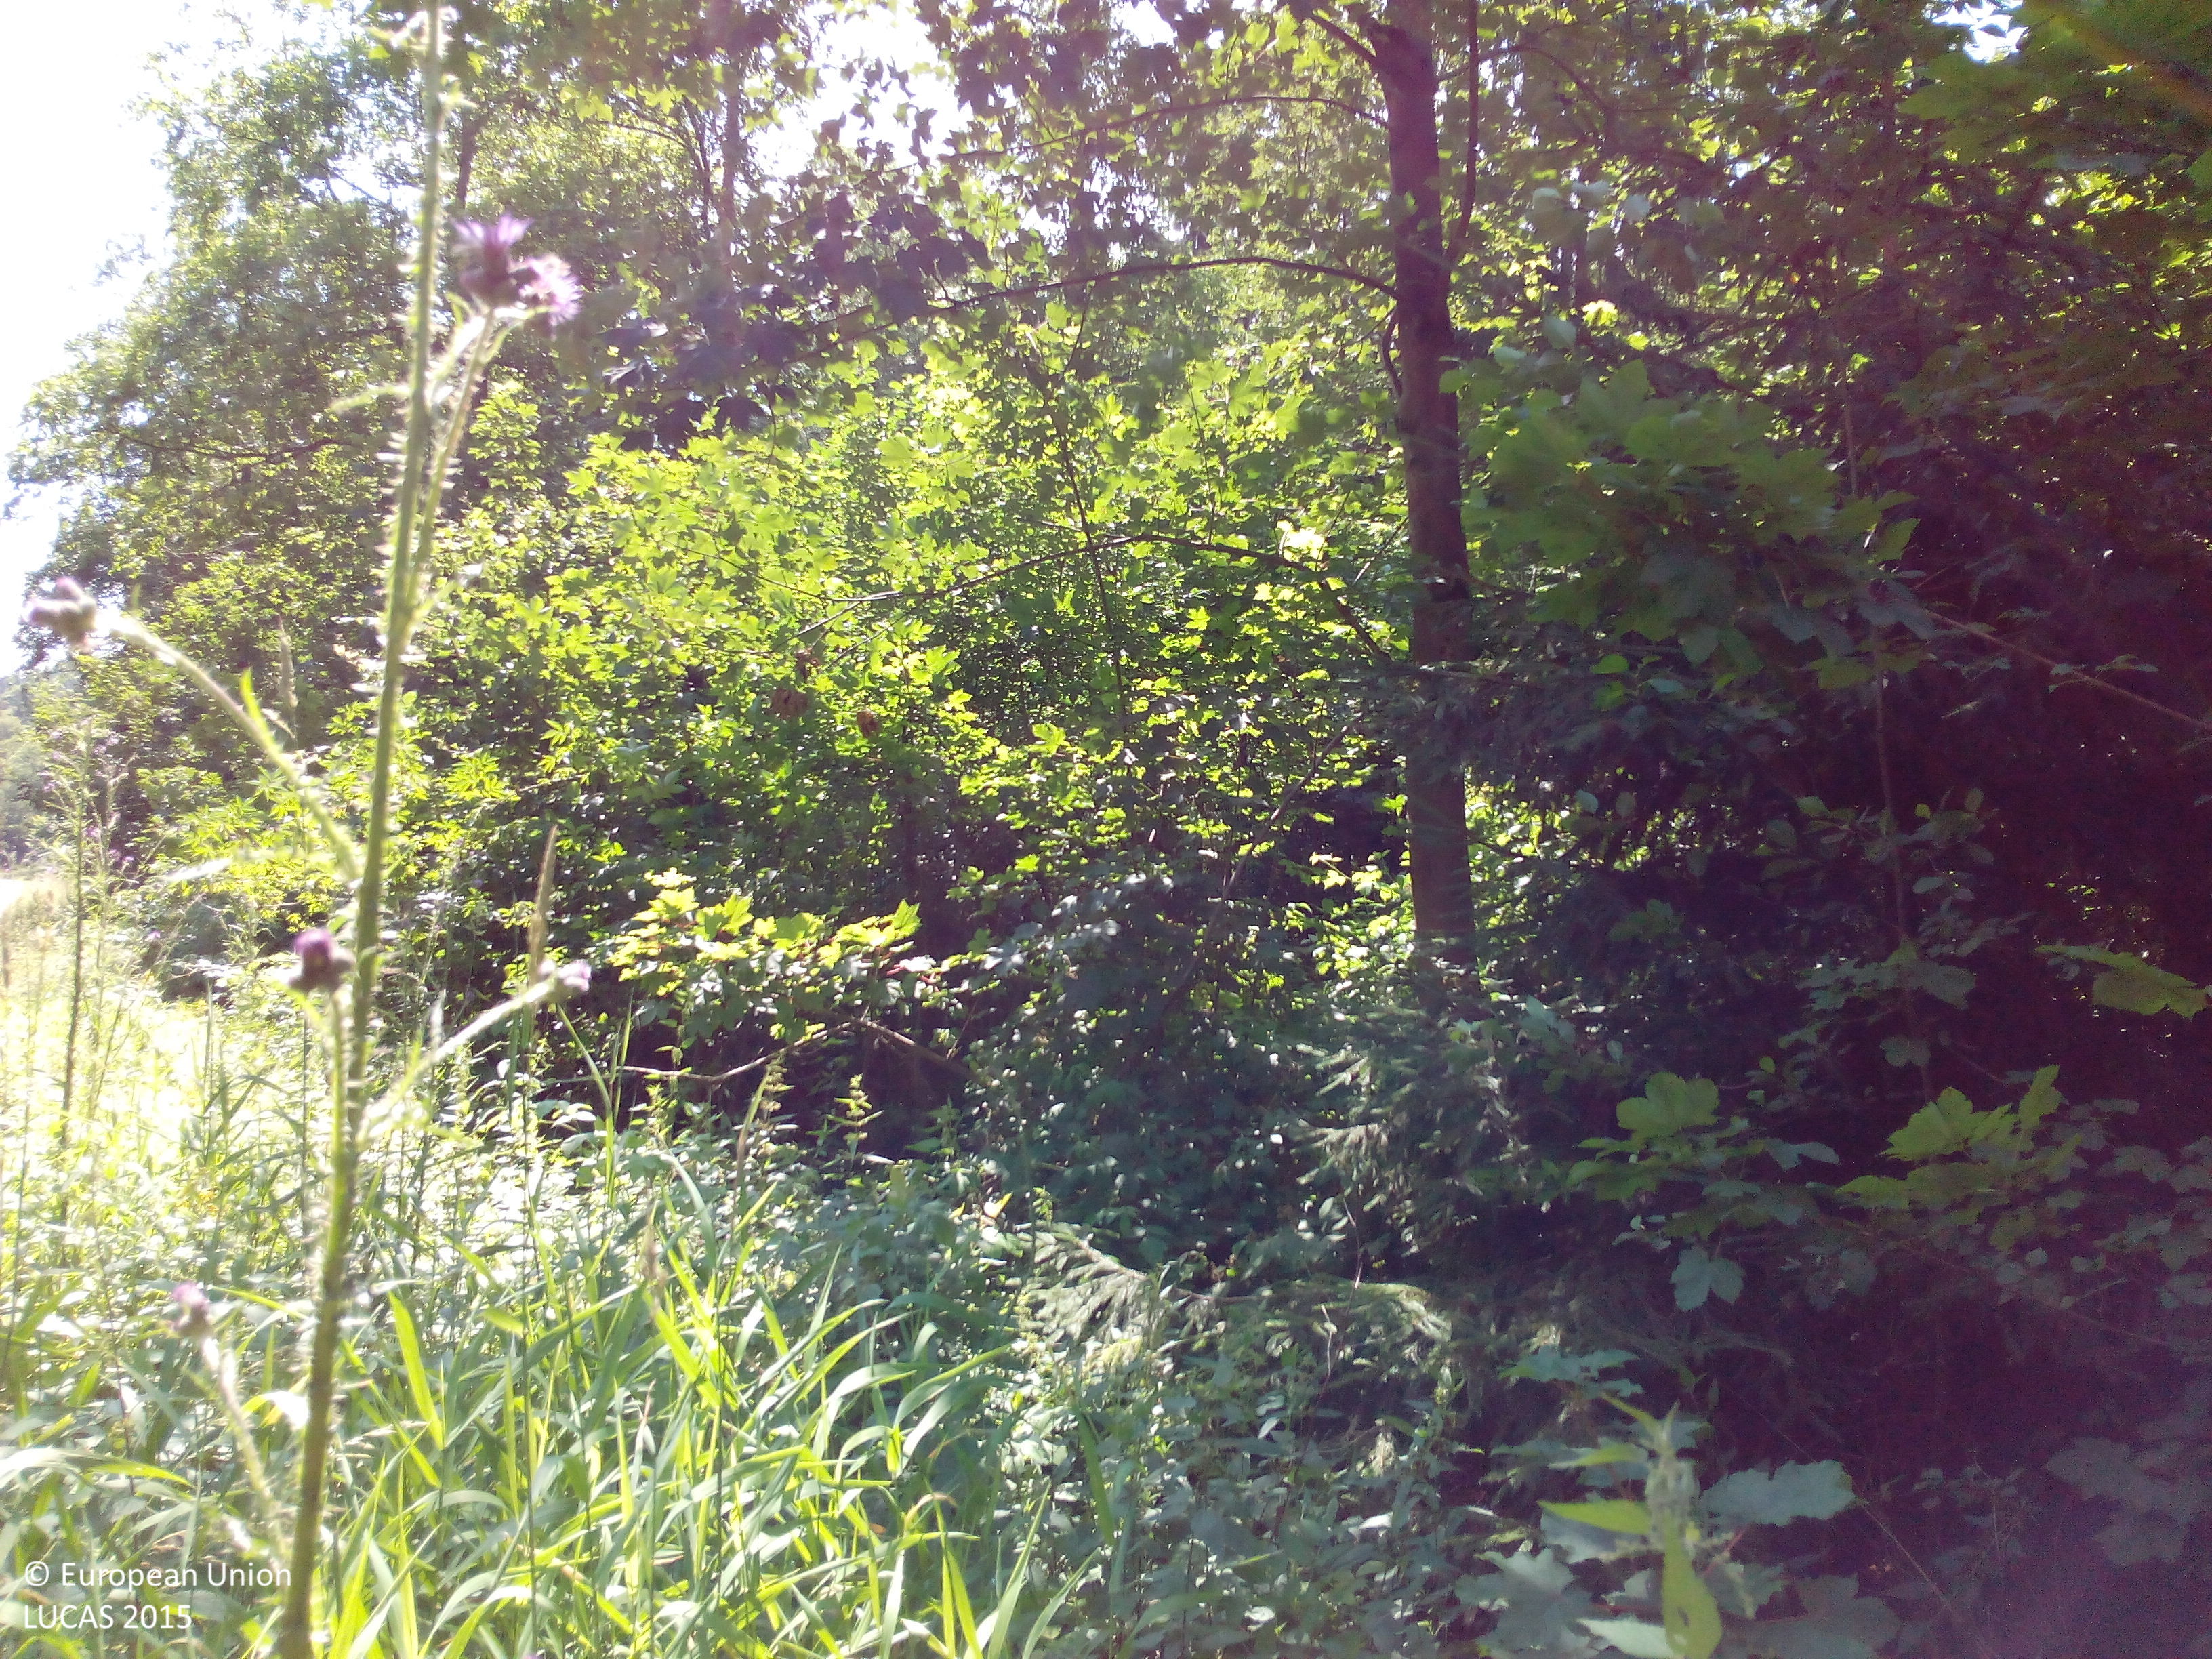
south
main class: Woodland
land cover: Broadleaved woodland
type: thermophilous deciduous forest
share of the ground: > 75 %
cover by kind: broadleaved forest trees 100 %
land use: Forestry
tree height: > 5 m
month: July
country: DE
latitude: 51.8918
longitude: 10.2760
